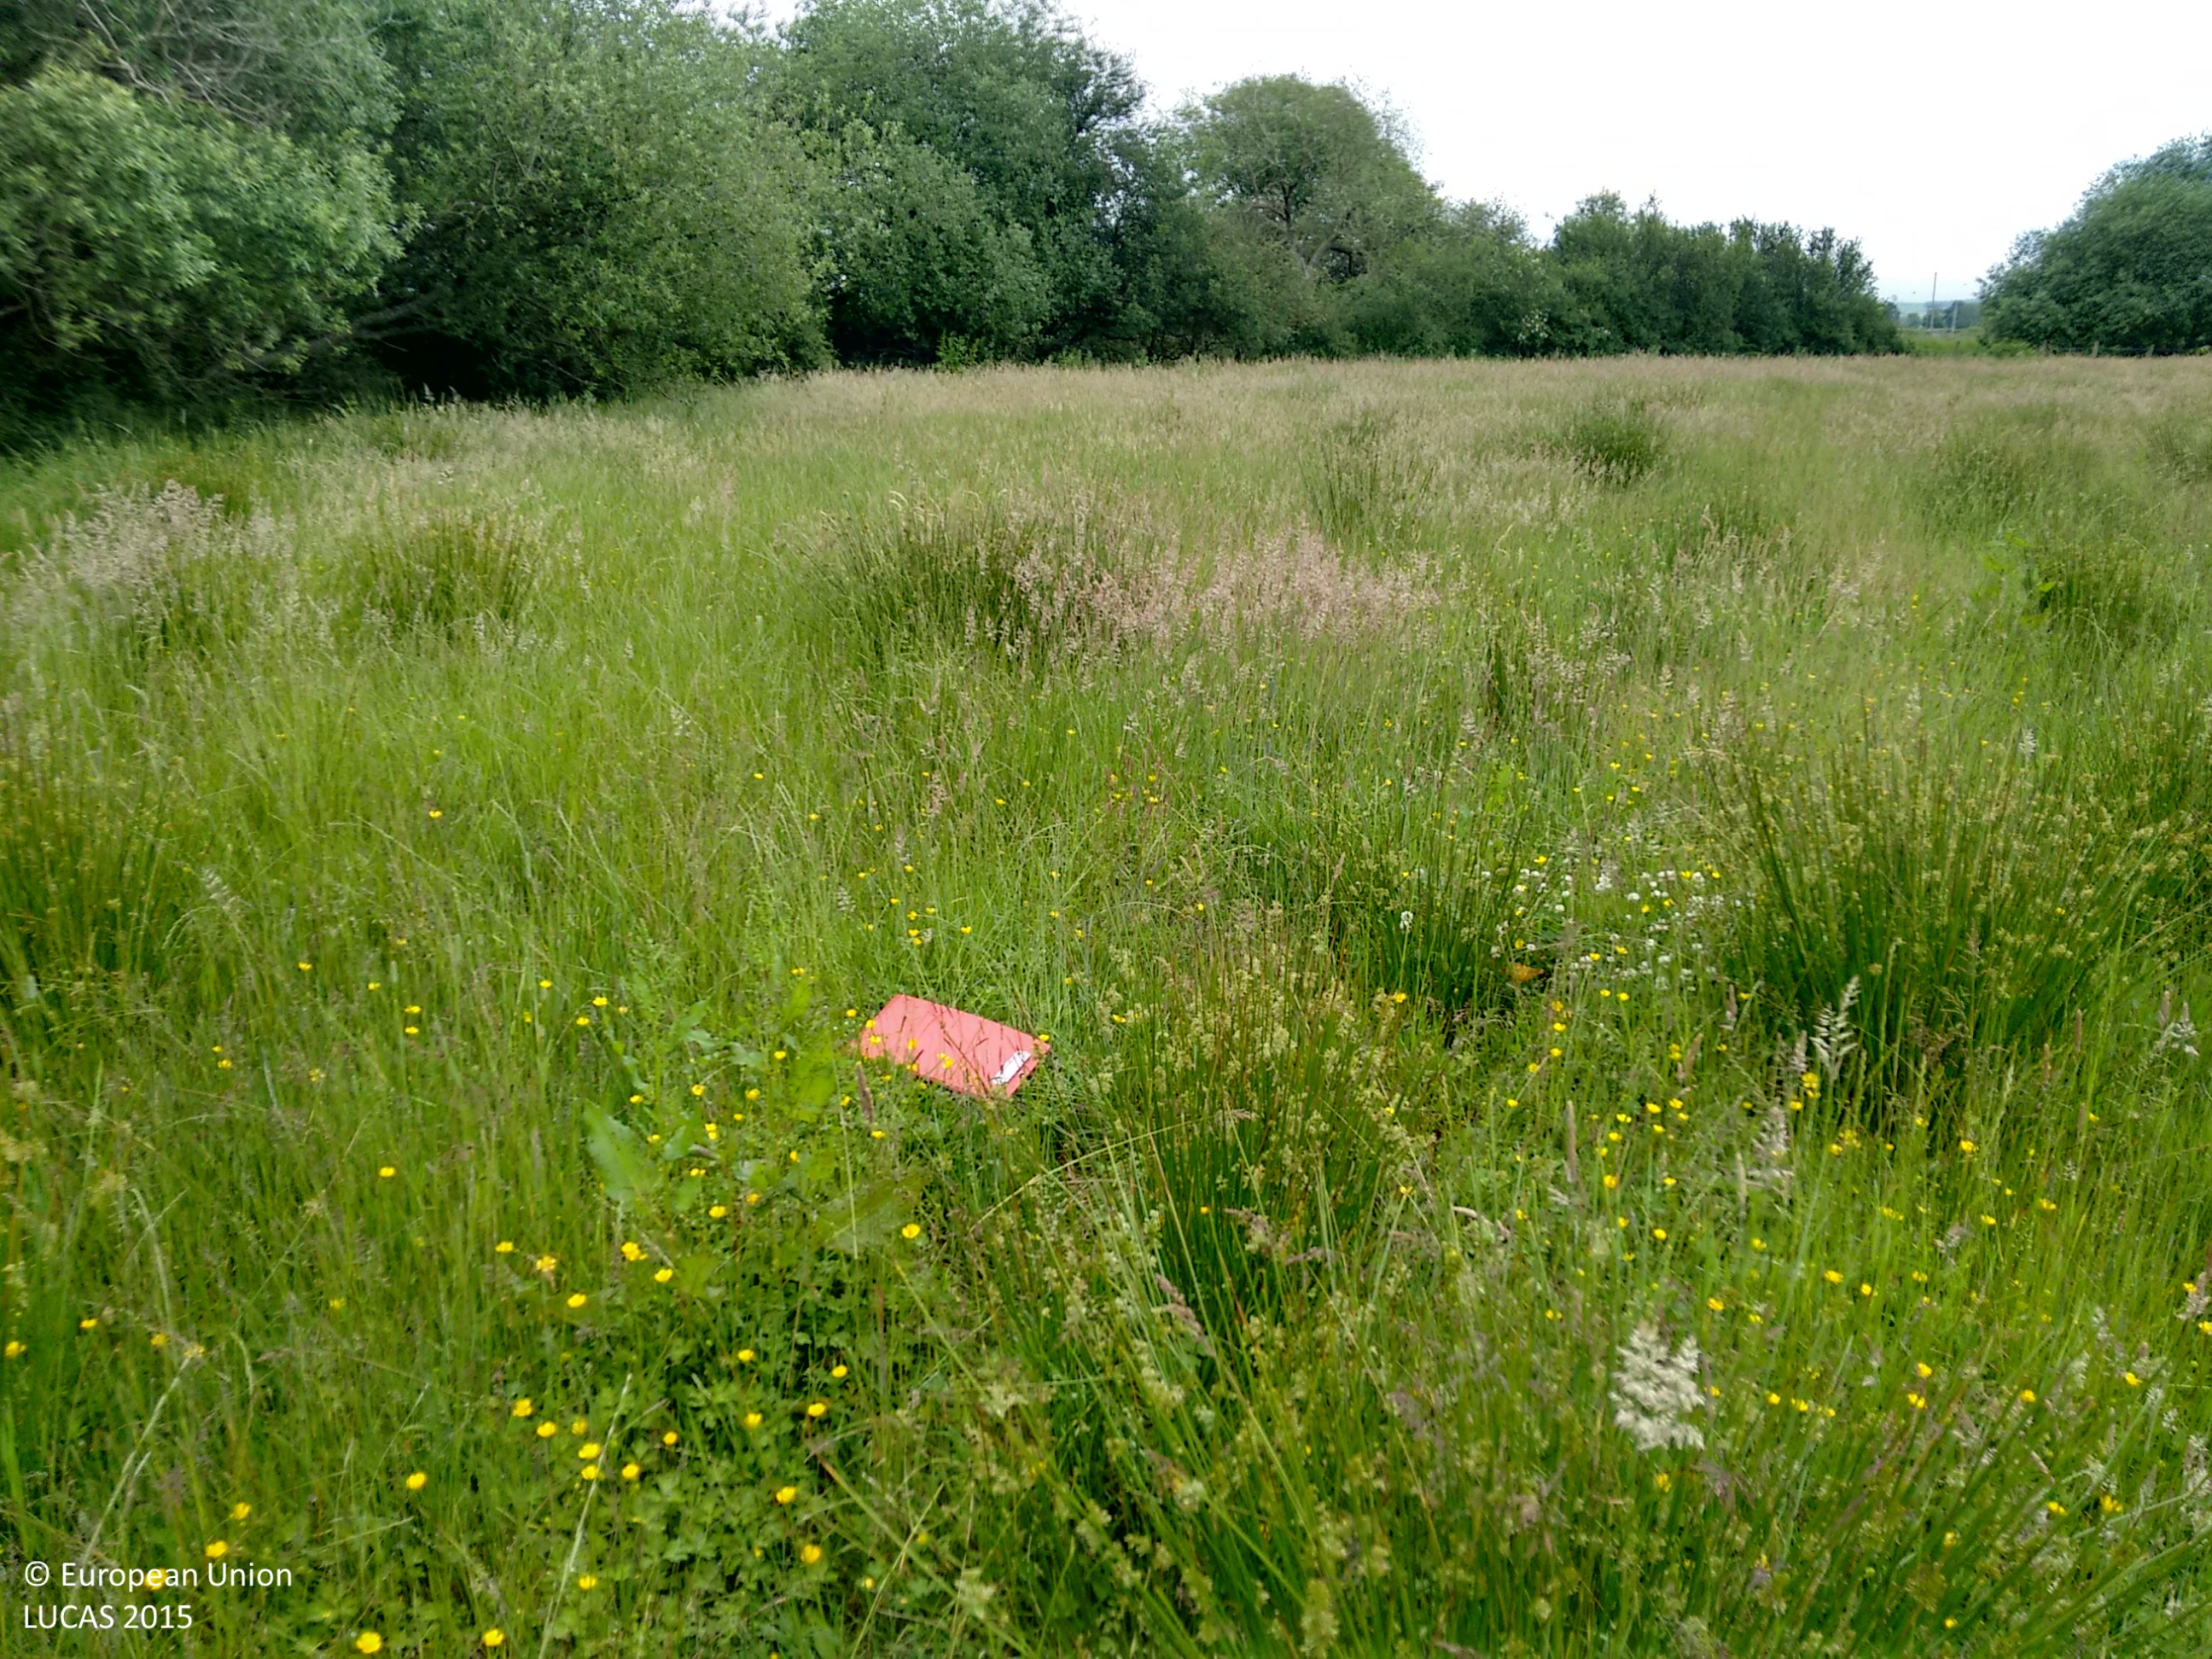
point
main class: Grassland
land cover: Grassland without tree/shrub cover
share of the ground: > 75 %
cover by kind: herbaceous plants 100 %
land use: Agriculture (excluding fallow land and kitchen gardens)
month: July
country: GB
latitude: 55.0196
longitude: -3.6119
